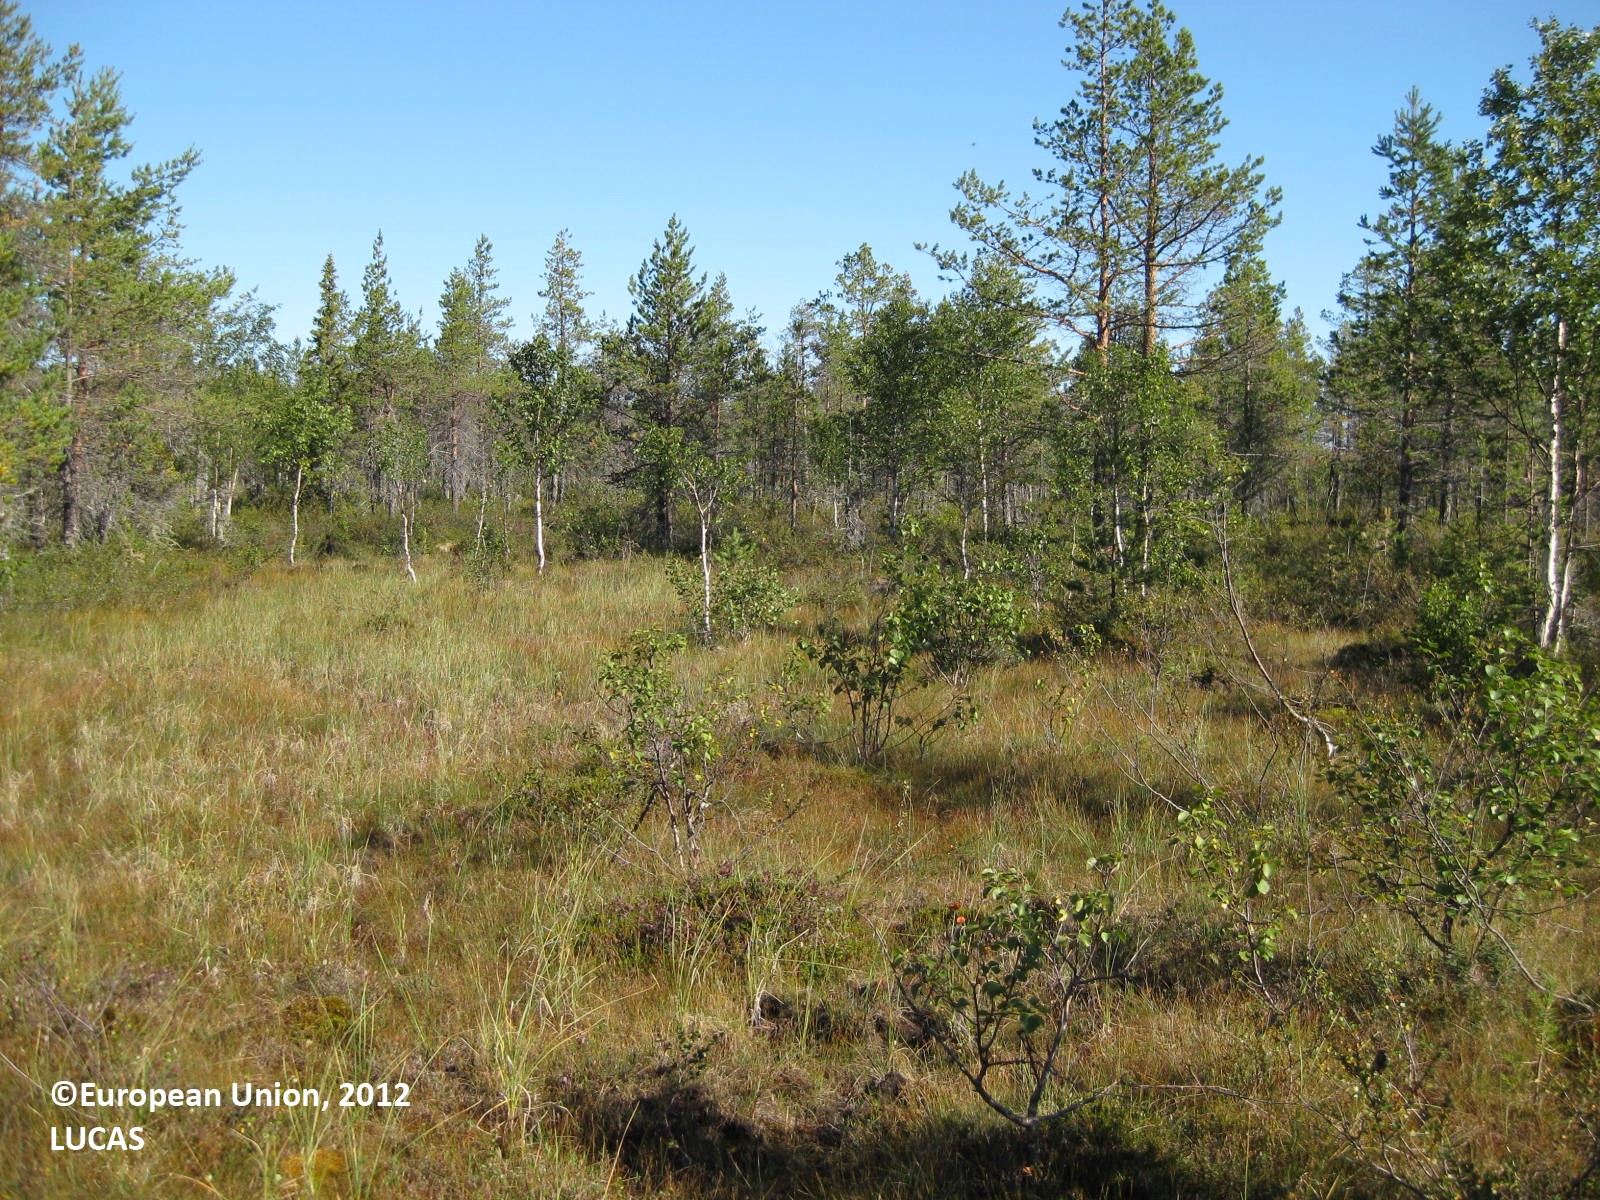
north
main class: Woodland
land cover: Pine dominated coniferous woodland
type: boreal forest
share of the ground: 25 - 50 %
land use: Forestry
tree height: > 5 m
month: August
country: FI
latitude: 66.5272
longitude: 28.5276
